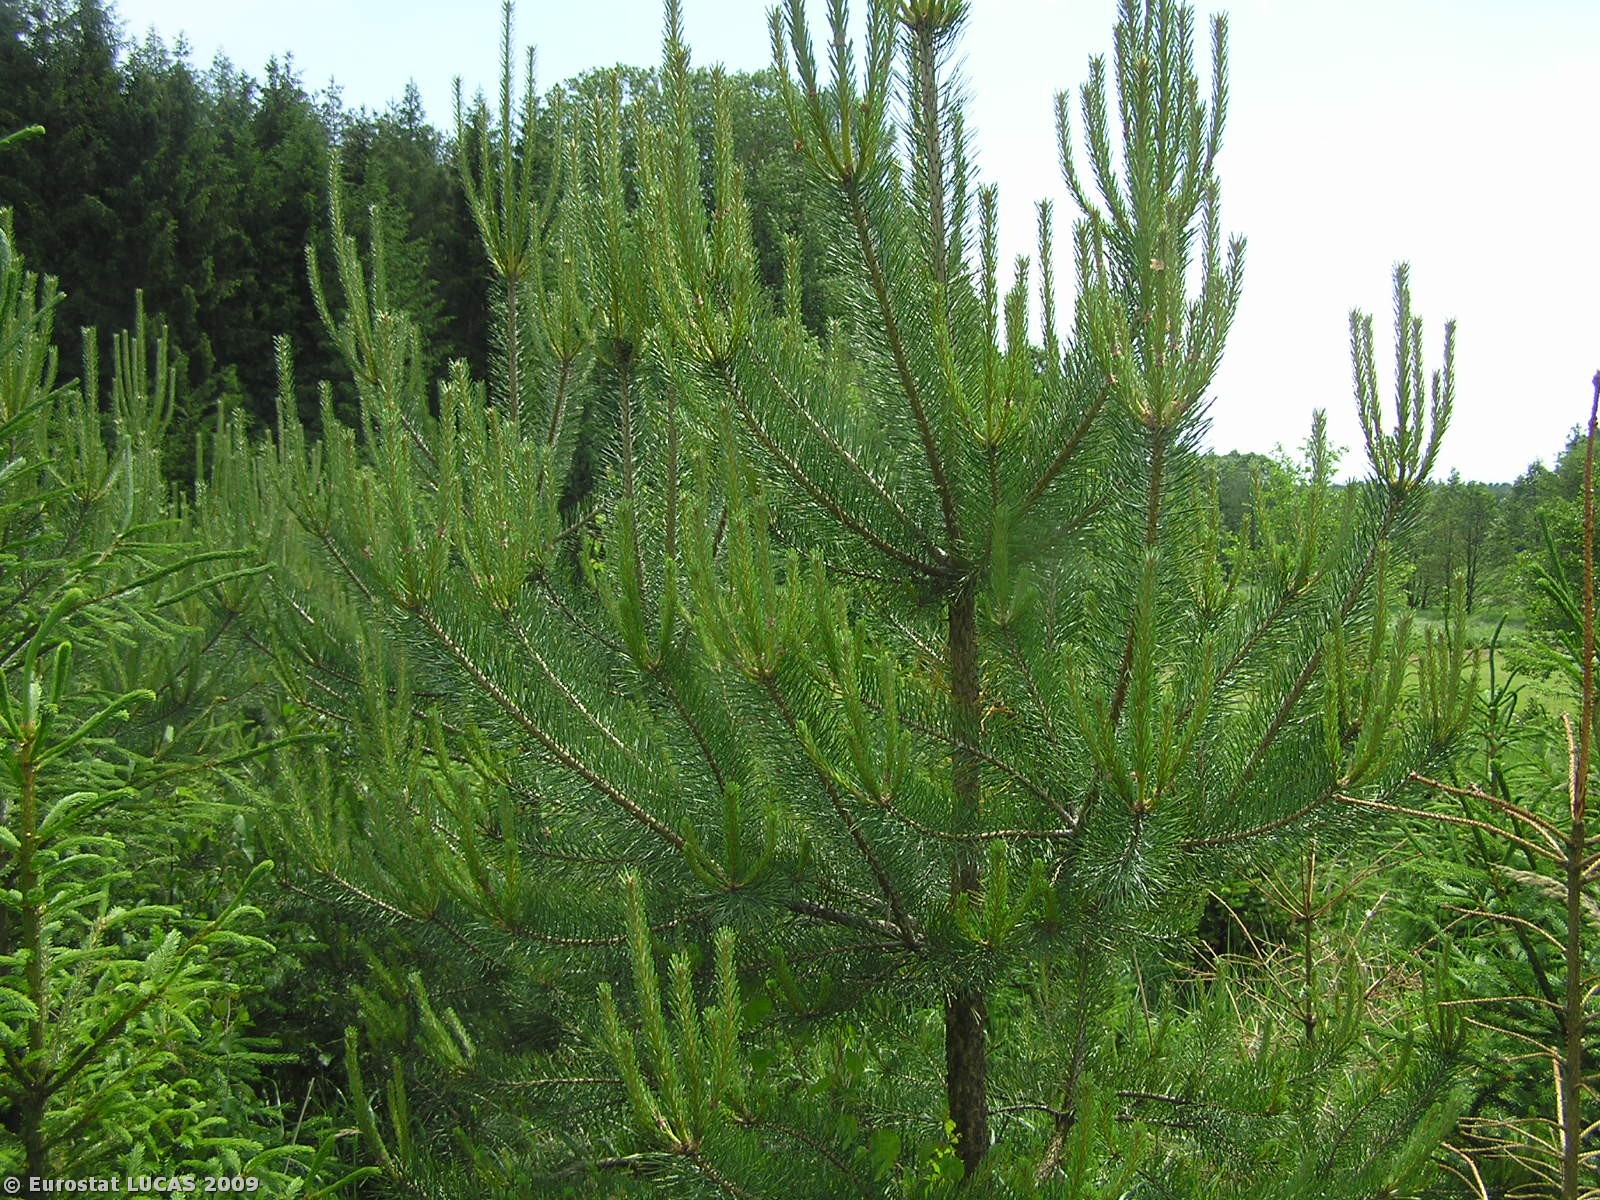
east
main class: Woodland
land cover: Coniferous woodland
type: hemiboreal forest and nemoral coniferous forest and mixed broadleaved-coniferous forest
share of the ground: > 75 %
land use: Forestry
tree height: > 5 m
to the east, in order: Coniferous woodland; Fences; Ditches and canals; Grassland without tree/shrub cover; Coniferous woodland; Common wheat
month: June
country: CZ
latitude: 49.6421
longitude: 15.0018
